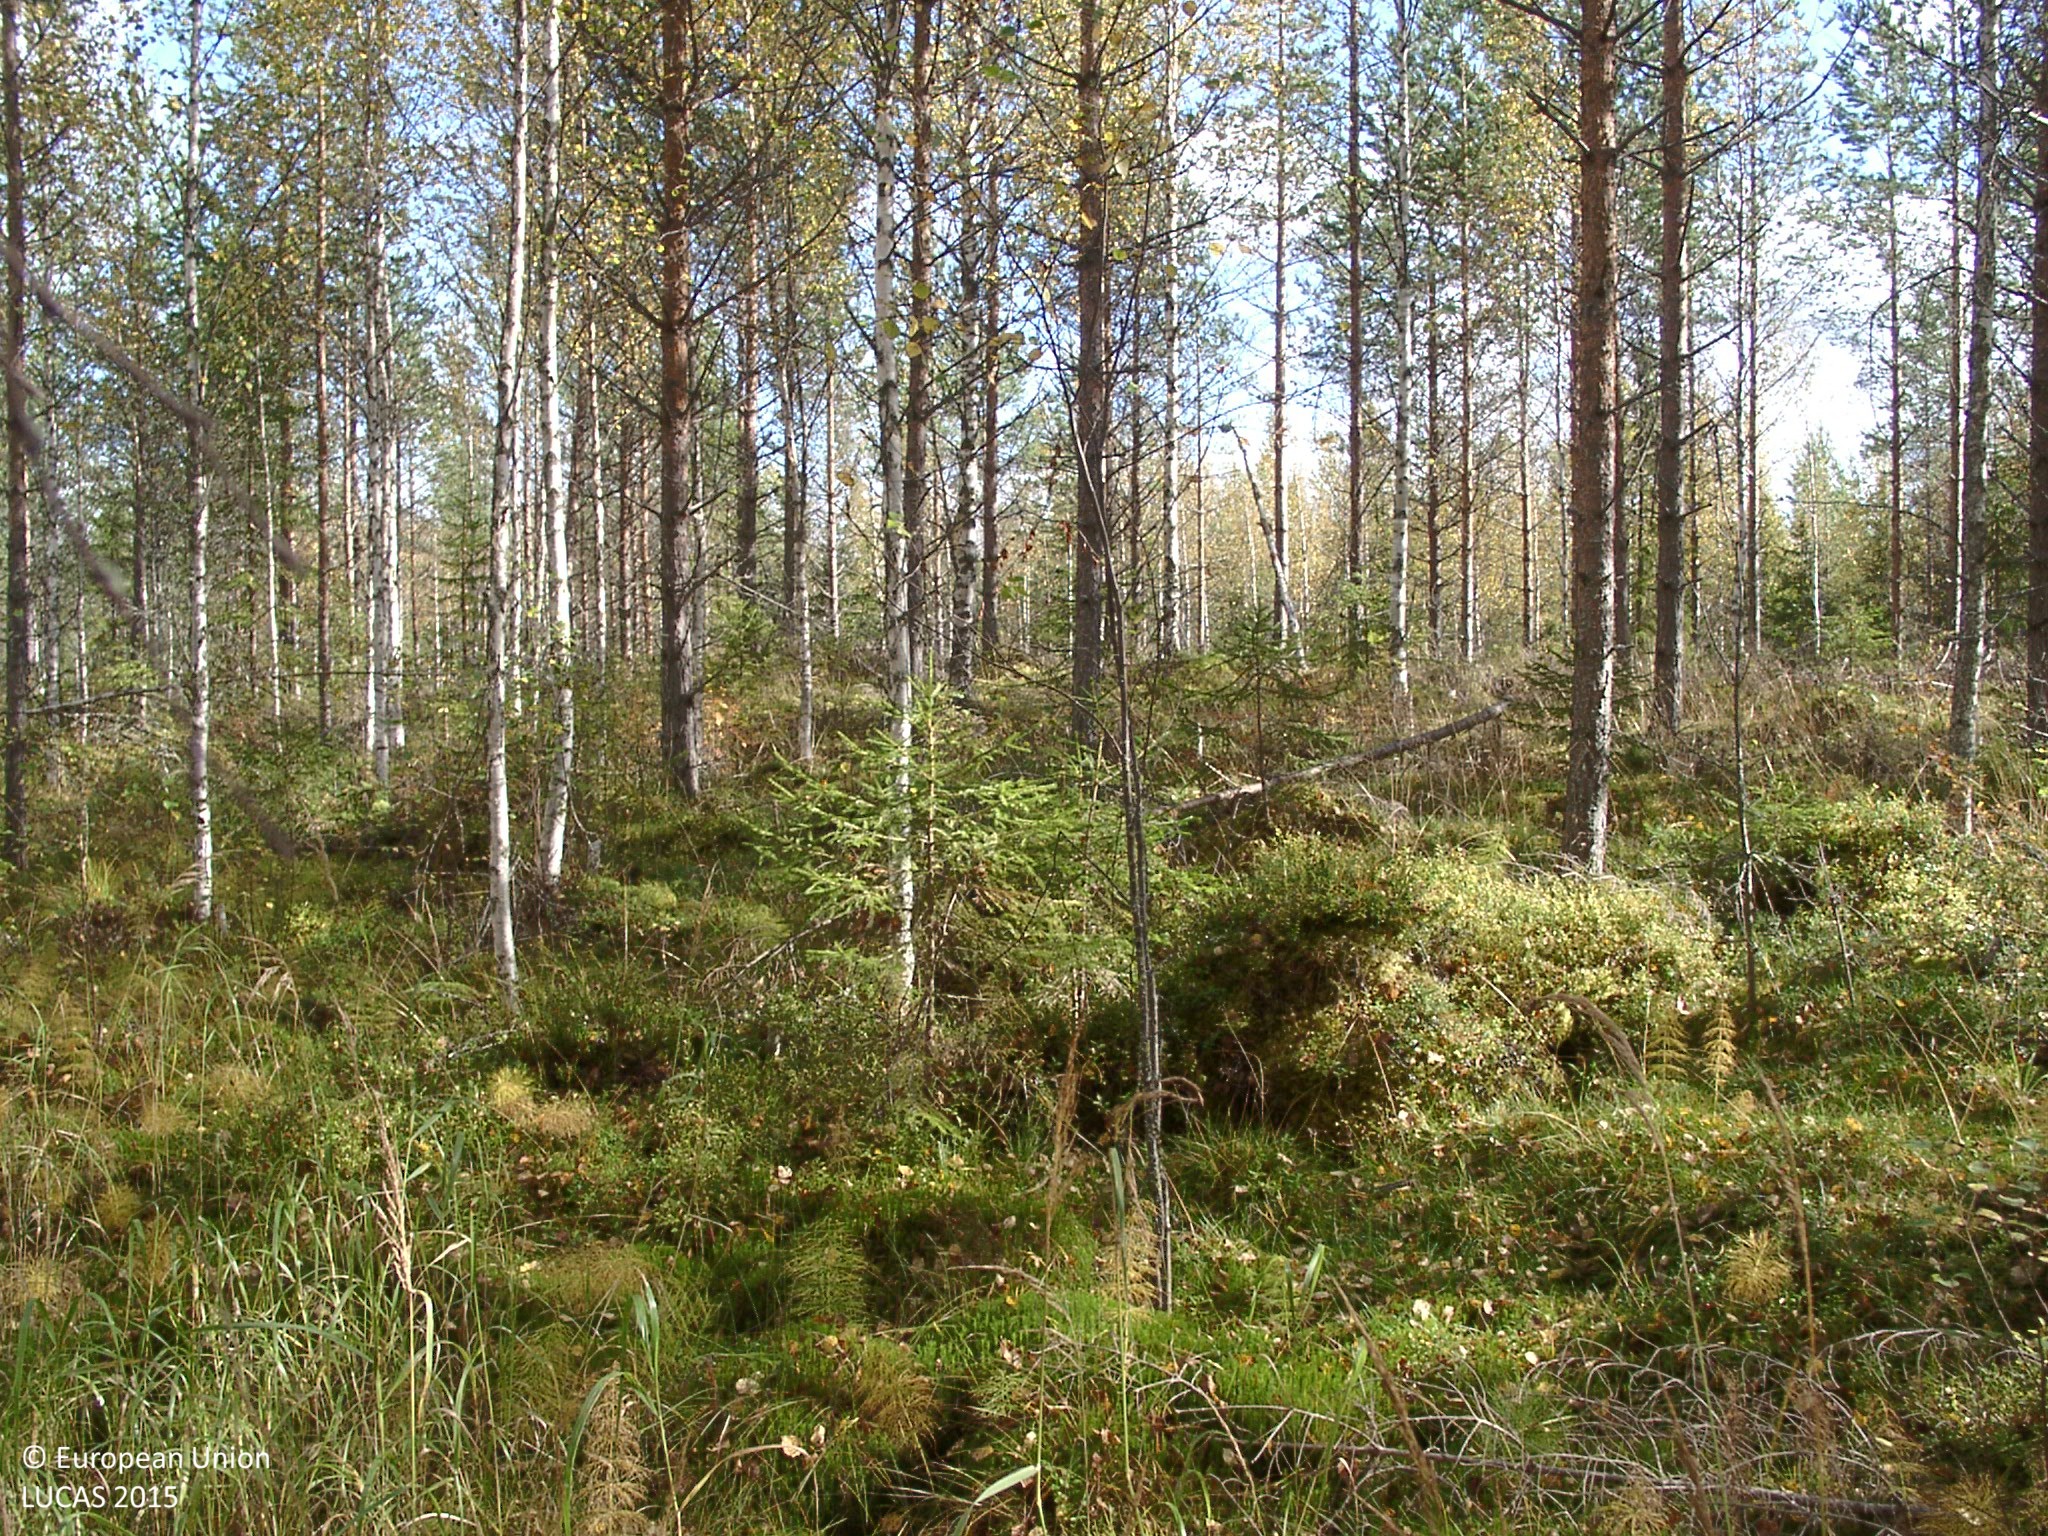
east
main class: Woodland
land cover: Pine dominated mixed woodland
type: boreal forest
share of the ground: 50 - 75 %
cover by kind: broadleaved forest trees 45 %, herbaceous plants 25 %, coniferous forest trees 15 %, lichens and mosses 10 %, shrubs 5 %
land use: Forestry
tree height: > 5 m
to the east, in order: Pine dominated mixed woodland; Tracks; Pine dominated mixed woodland; Ditches and canals; Pine dominated mixed woodland; Pine dominated coniferous woodland; Pine dominated mixed woodland; Pine dominated coniferous woodland
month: September
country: FI
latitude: 62.5182
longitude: 25.3564
